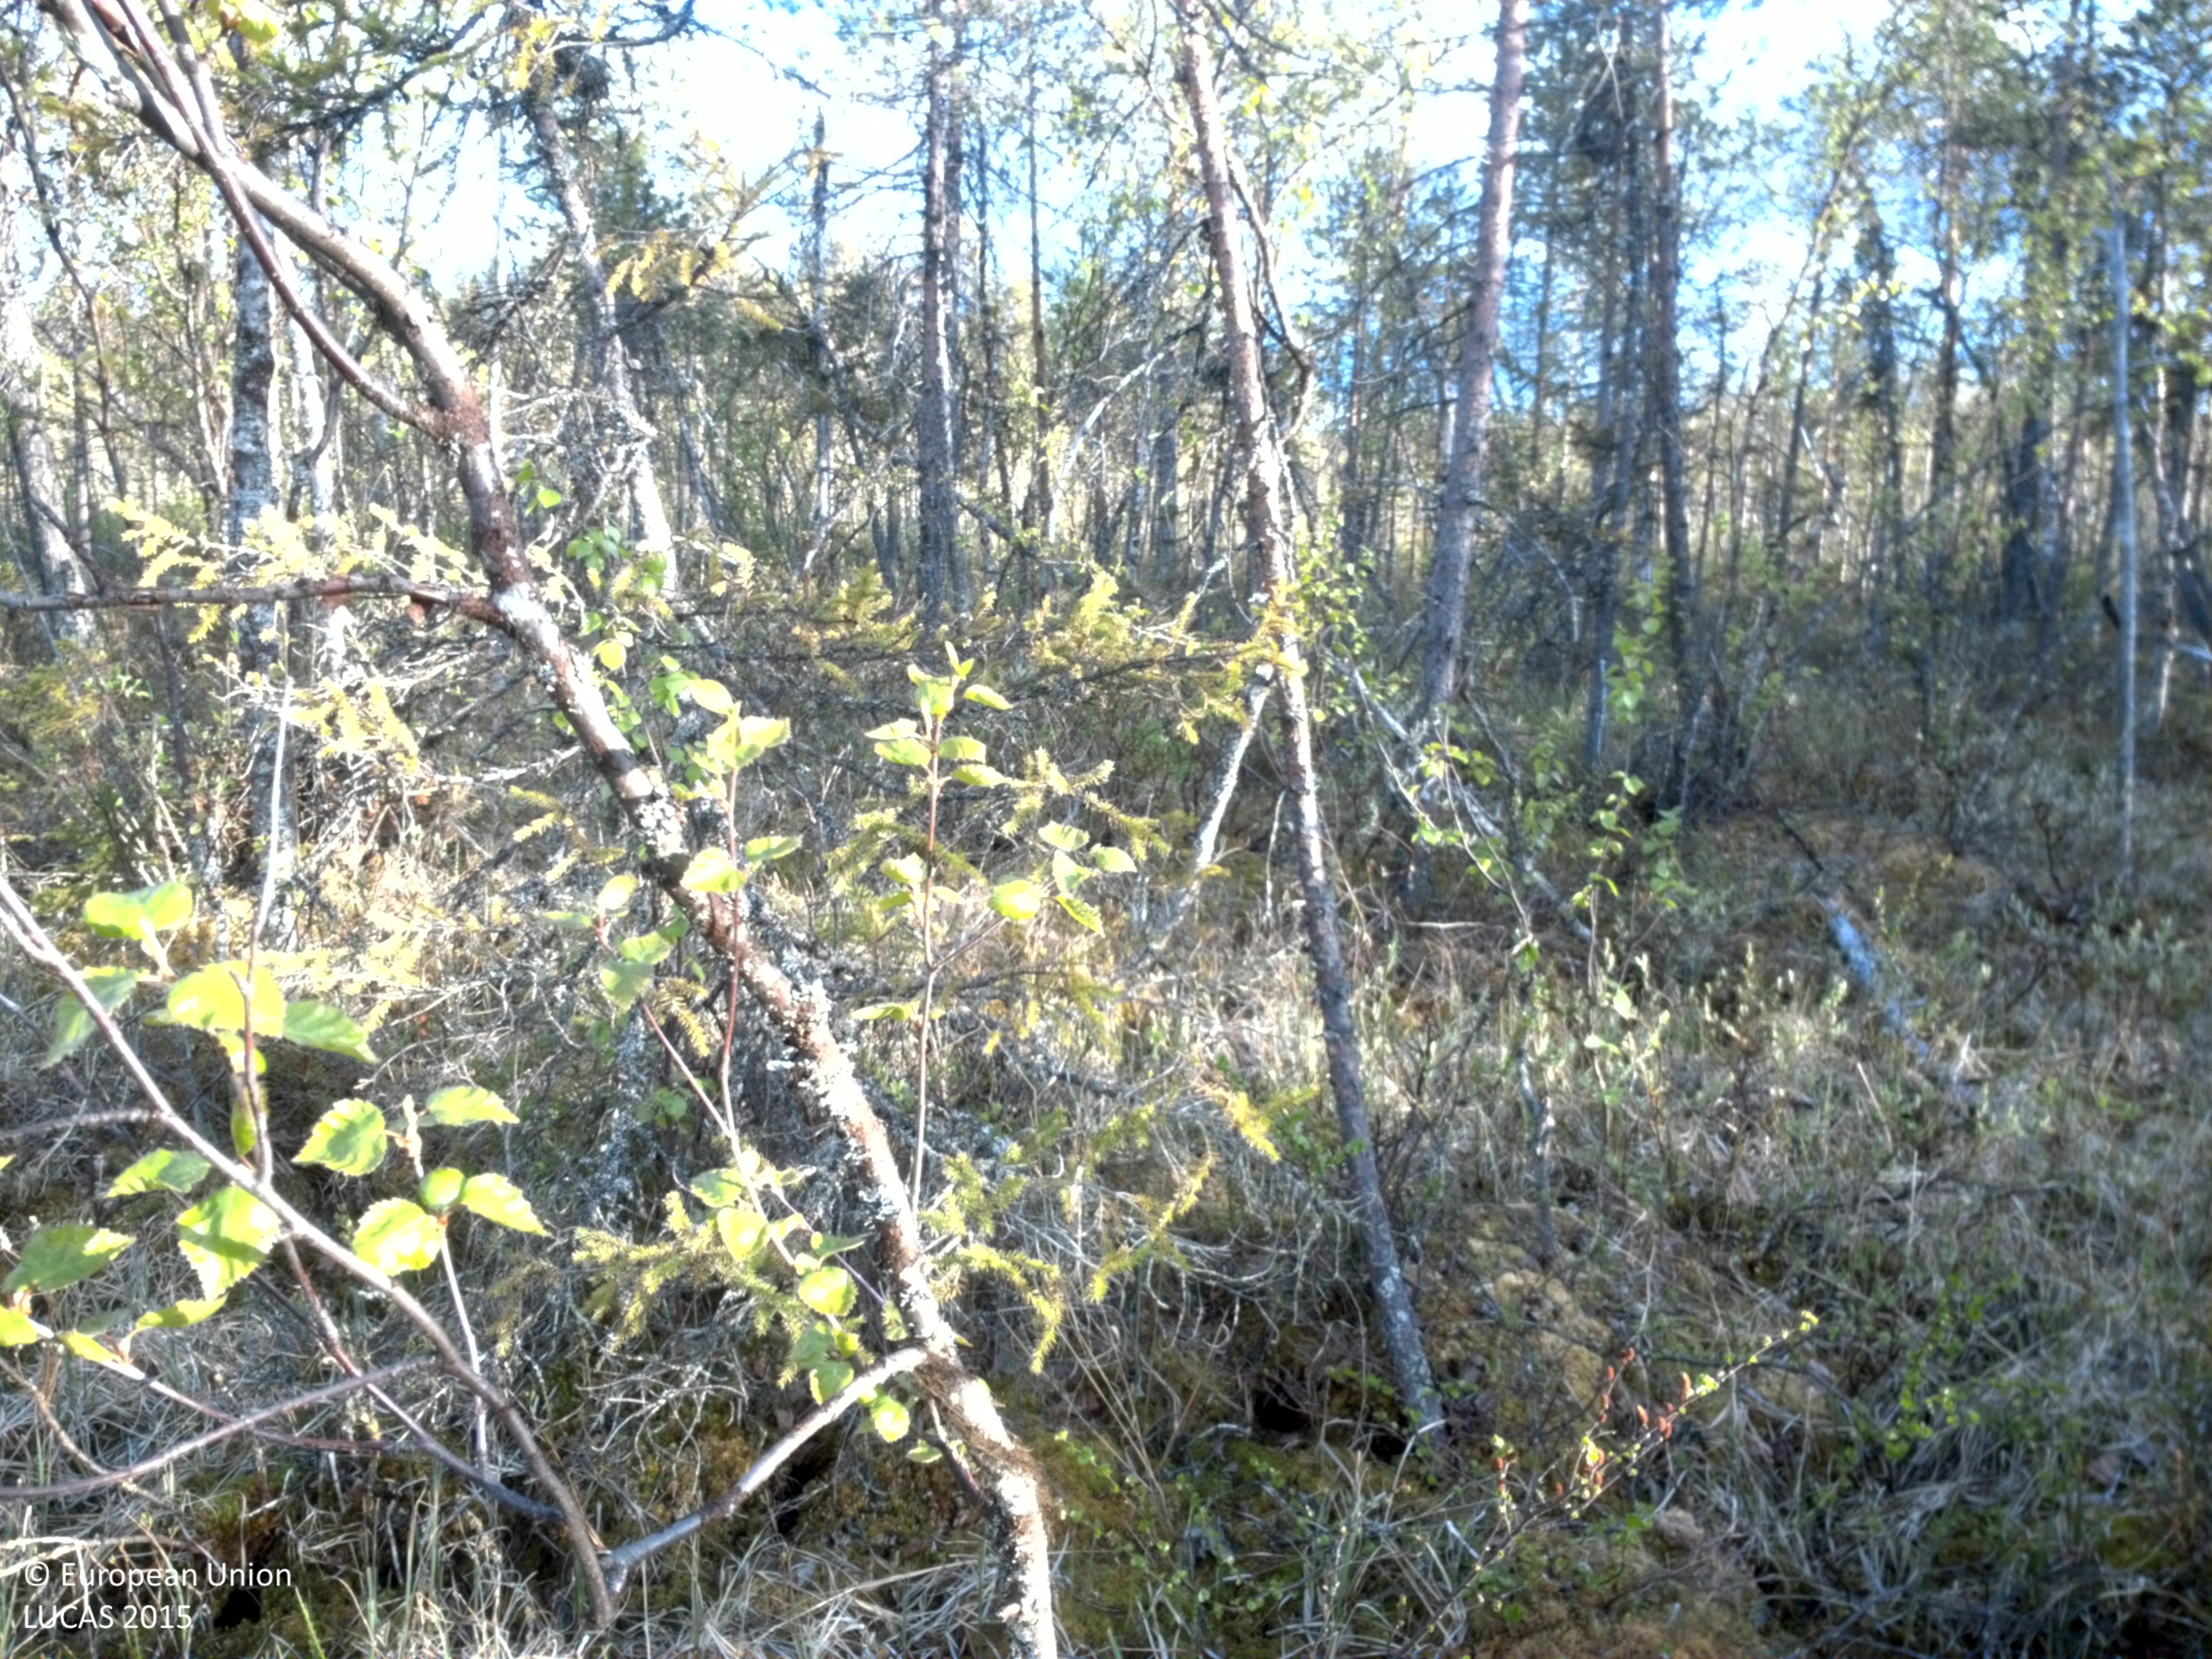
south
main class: Woodland
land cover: Pine dominated mixed woodland
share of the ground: 10 - 25 %
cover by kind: shrubs 50 %, herbaceous plants 20 %, coniferous forest trees 15 %, lichens and mosses 10 %, broadleaved forest trees 5 %
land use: Semi-natural and natural areas not in use
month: June
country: SE
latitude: 66.8826
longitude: 21.6220
